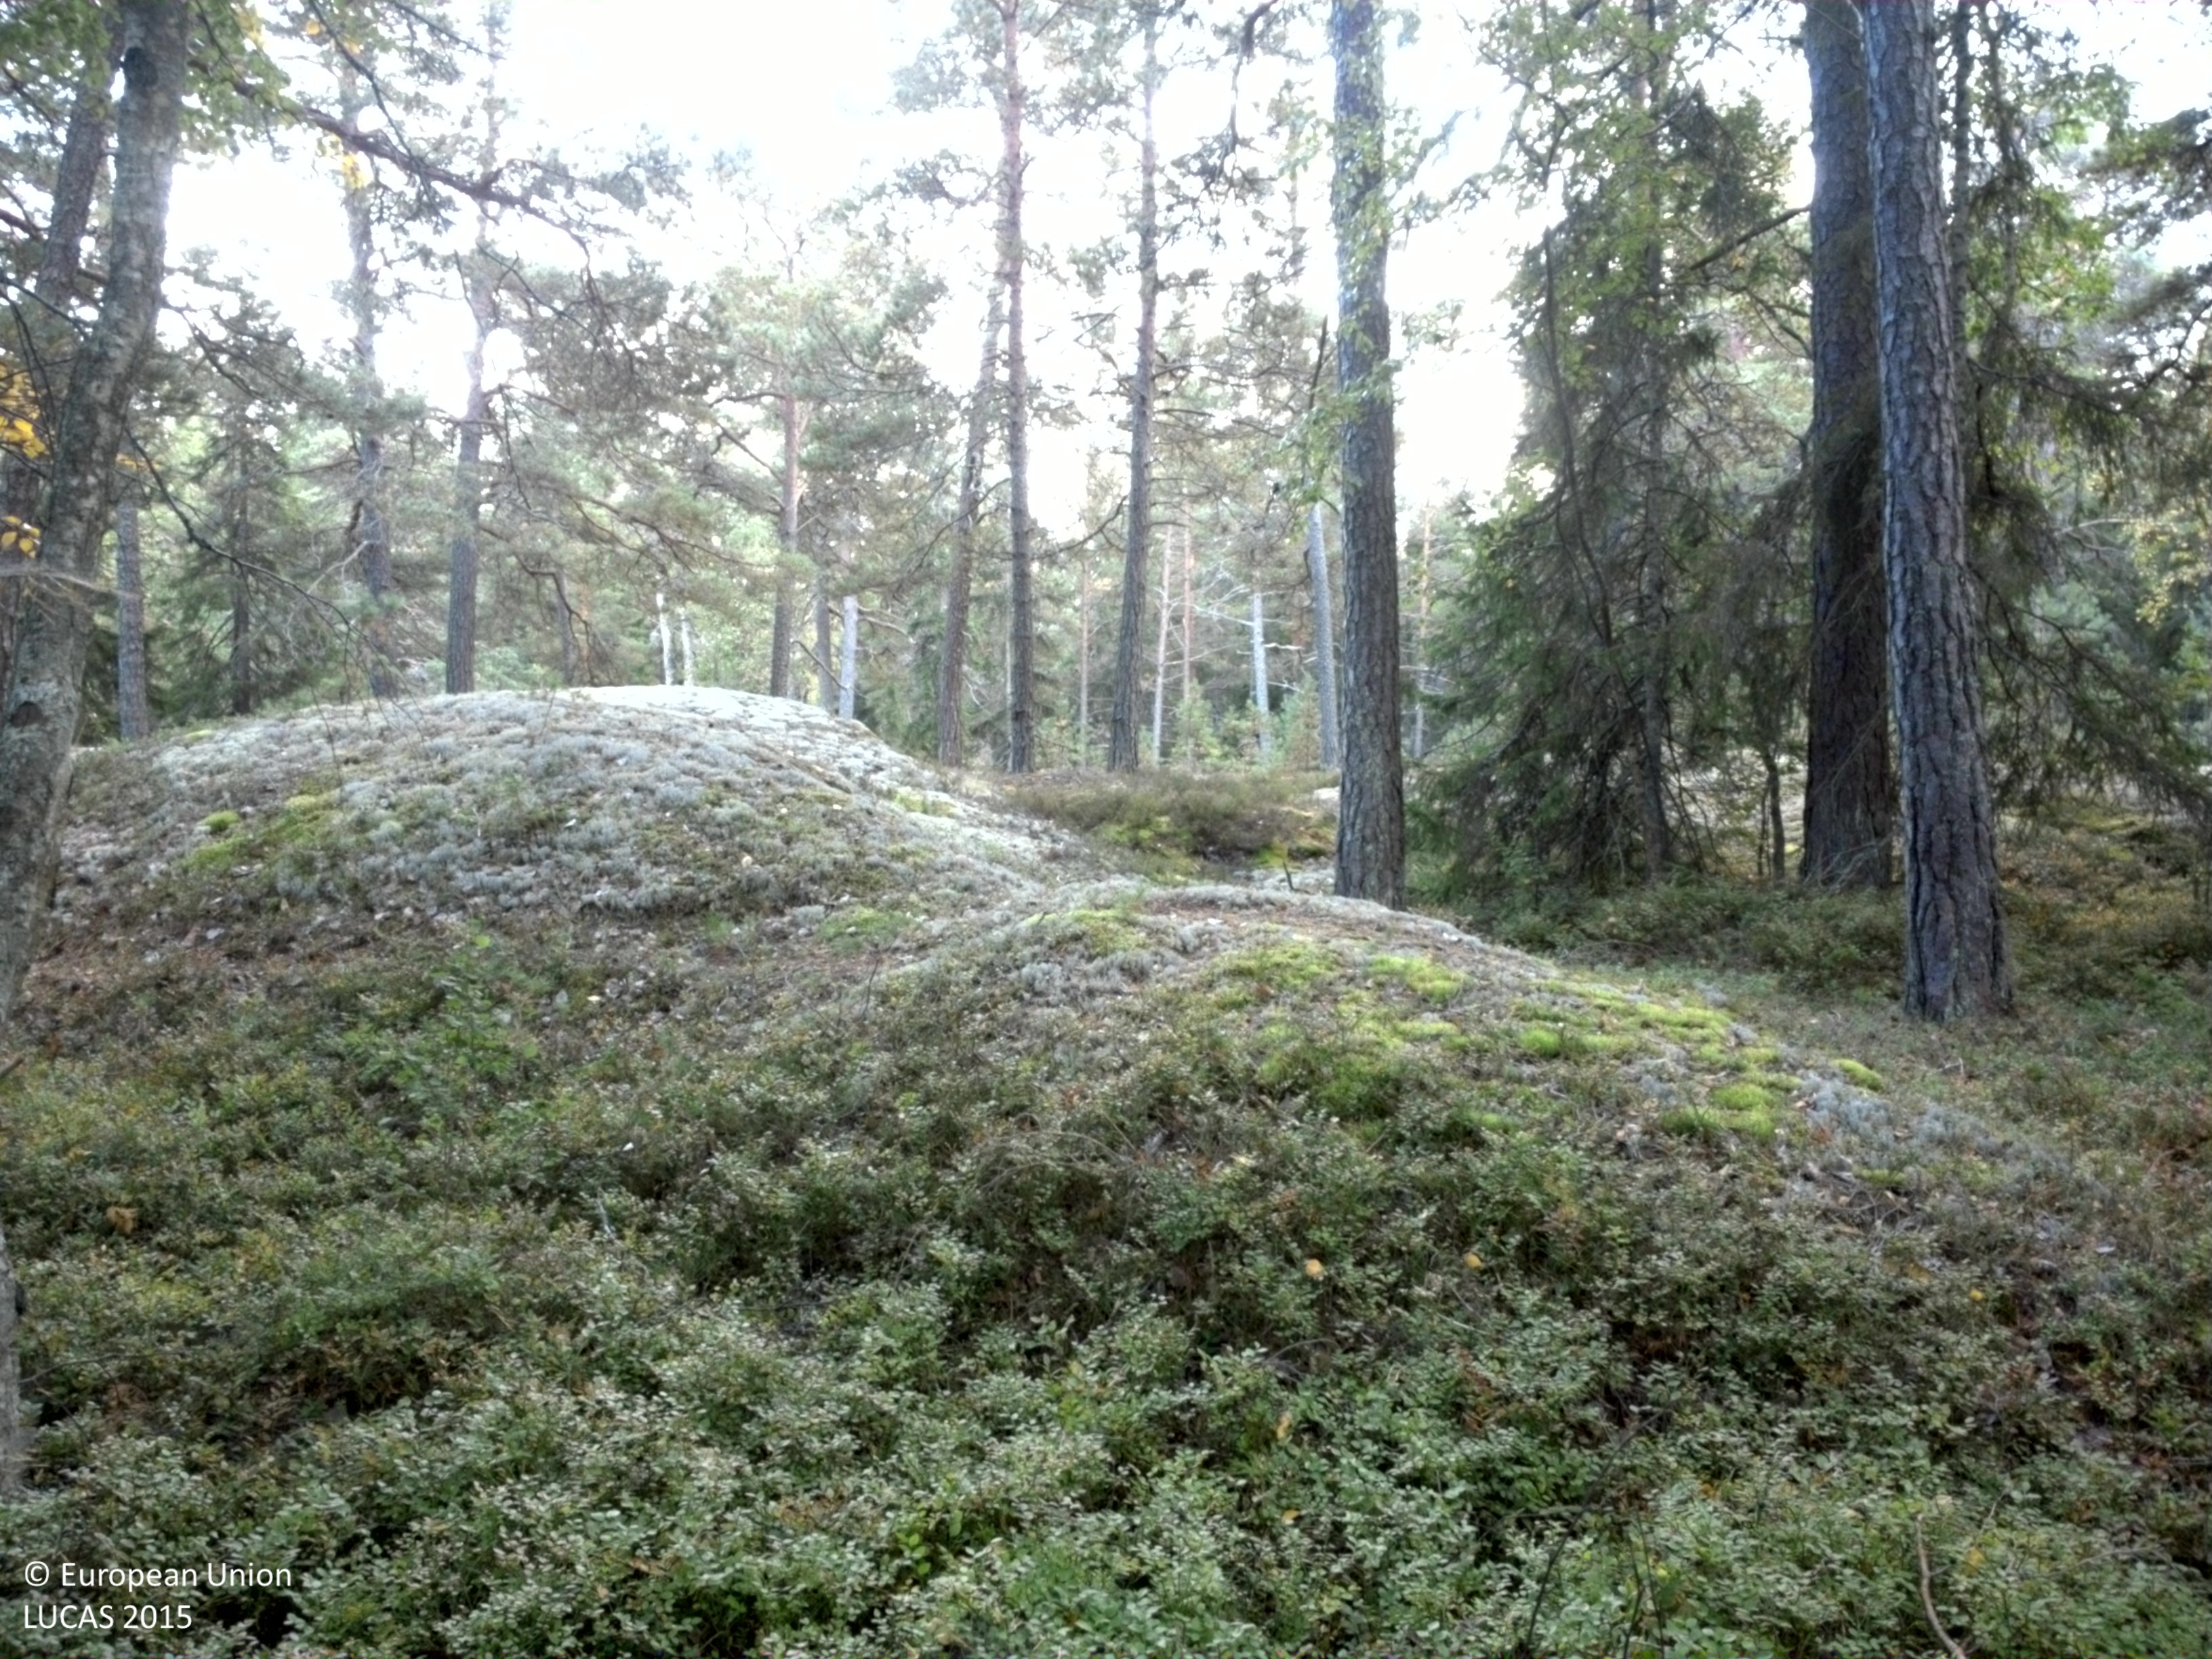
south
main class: Woodland
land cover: Pine dominated coniferous woodland
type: boreal forest
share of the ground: 50 - 75 %
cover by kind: coniferous forest trees 60 %, shrubs 25 %, lichens and mosses 15 %
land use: Forestry
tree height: > 5 m
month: September
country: SE
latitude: 59.3581
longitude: 18.5678
